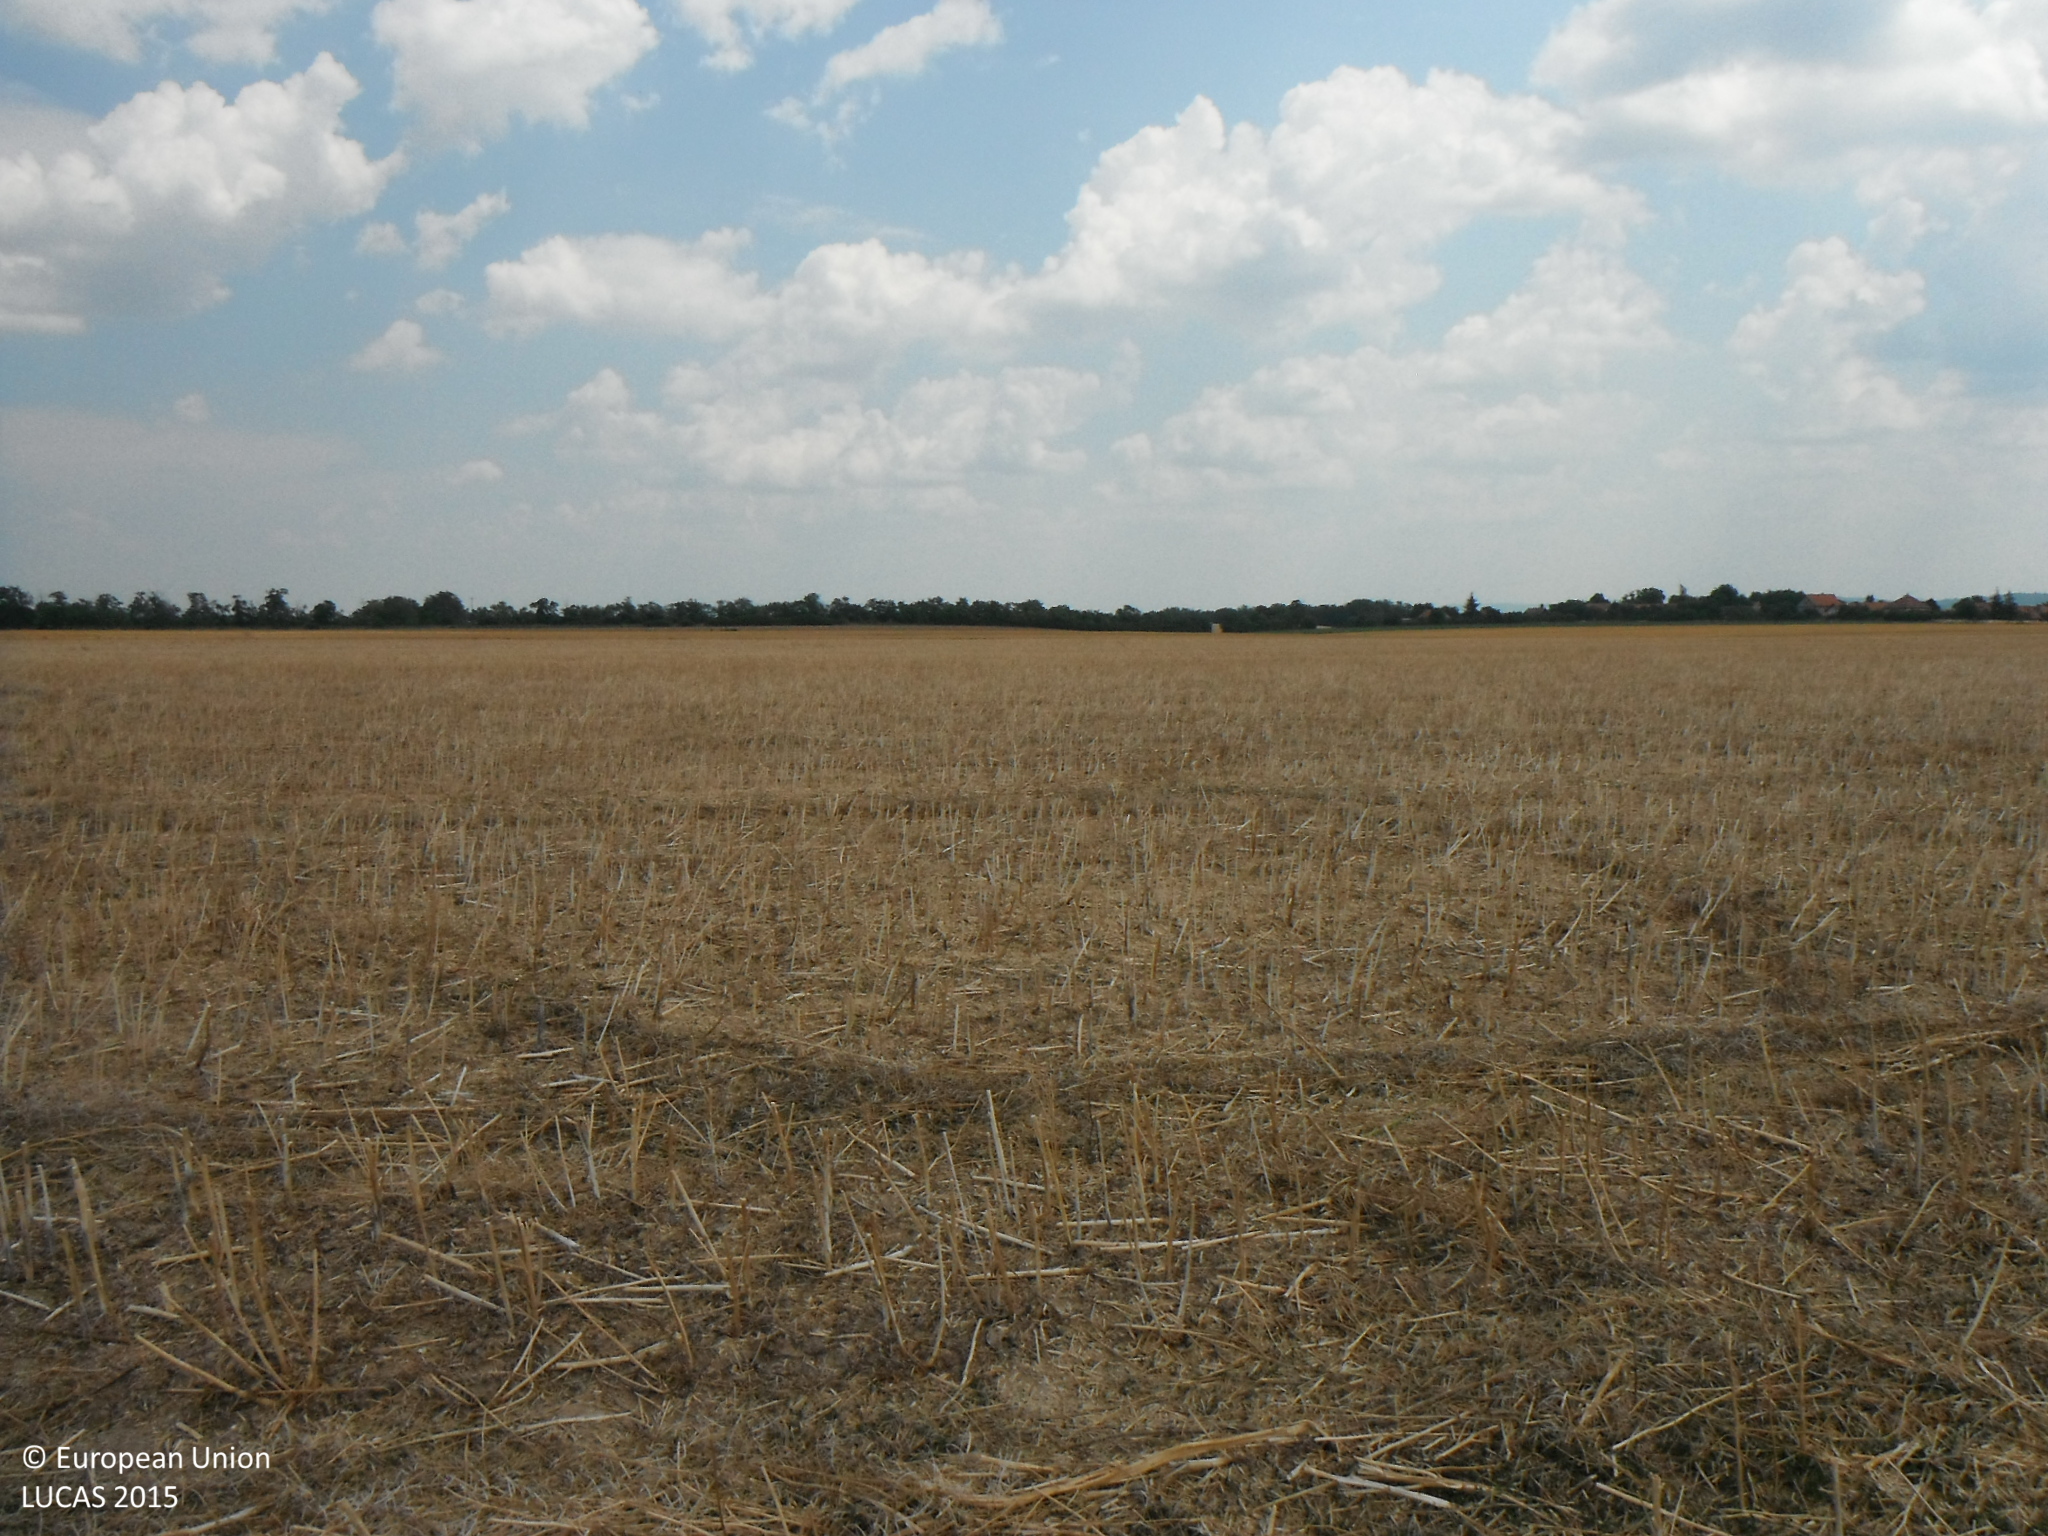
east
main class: Cropland
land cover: Rape and turnip rape
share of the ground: > 75 %
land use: Agriculture (excluding fallow land and kitchen gardens)
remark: Harvested field
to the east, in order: Rape and turnip rape; Barley
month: July
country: SK
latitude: 48.3128
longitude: 20.1844
